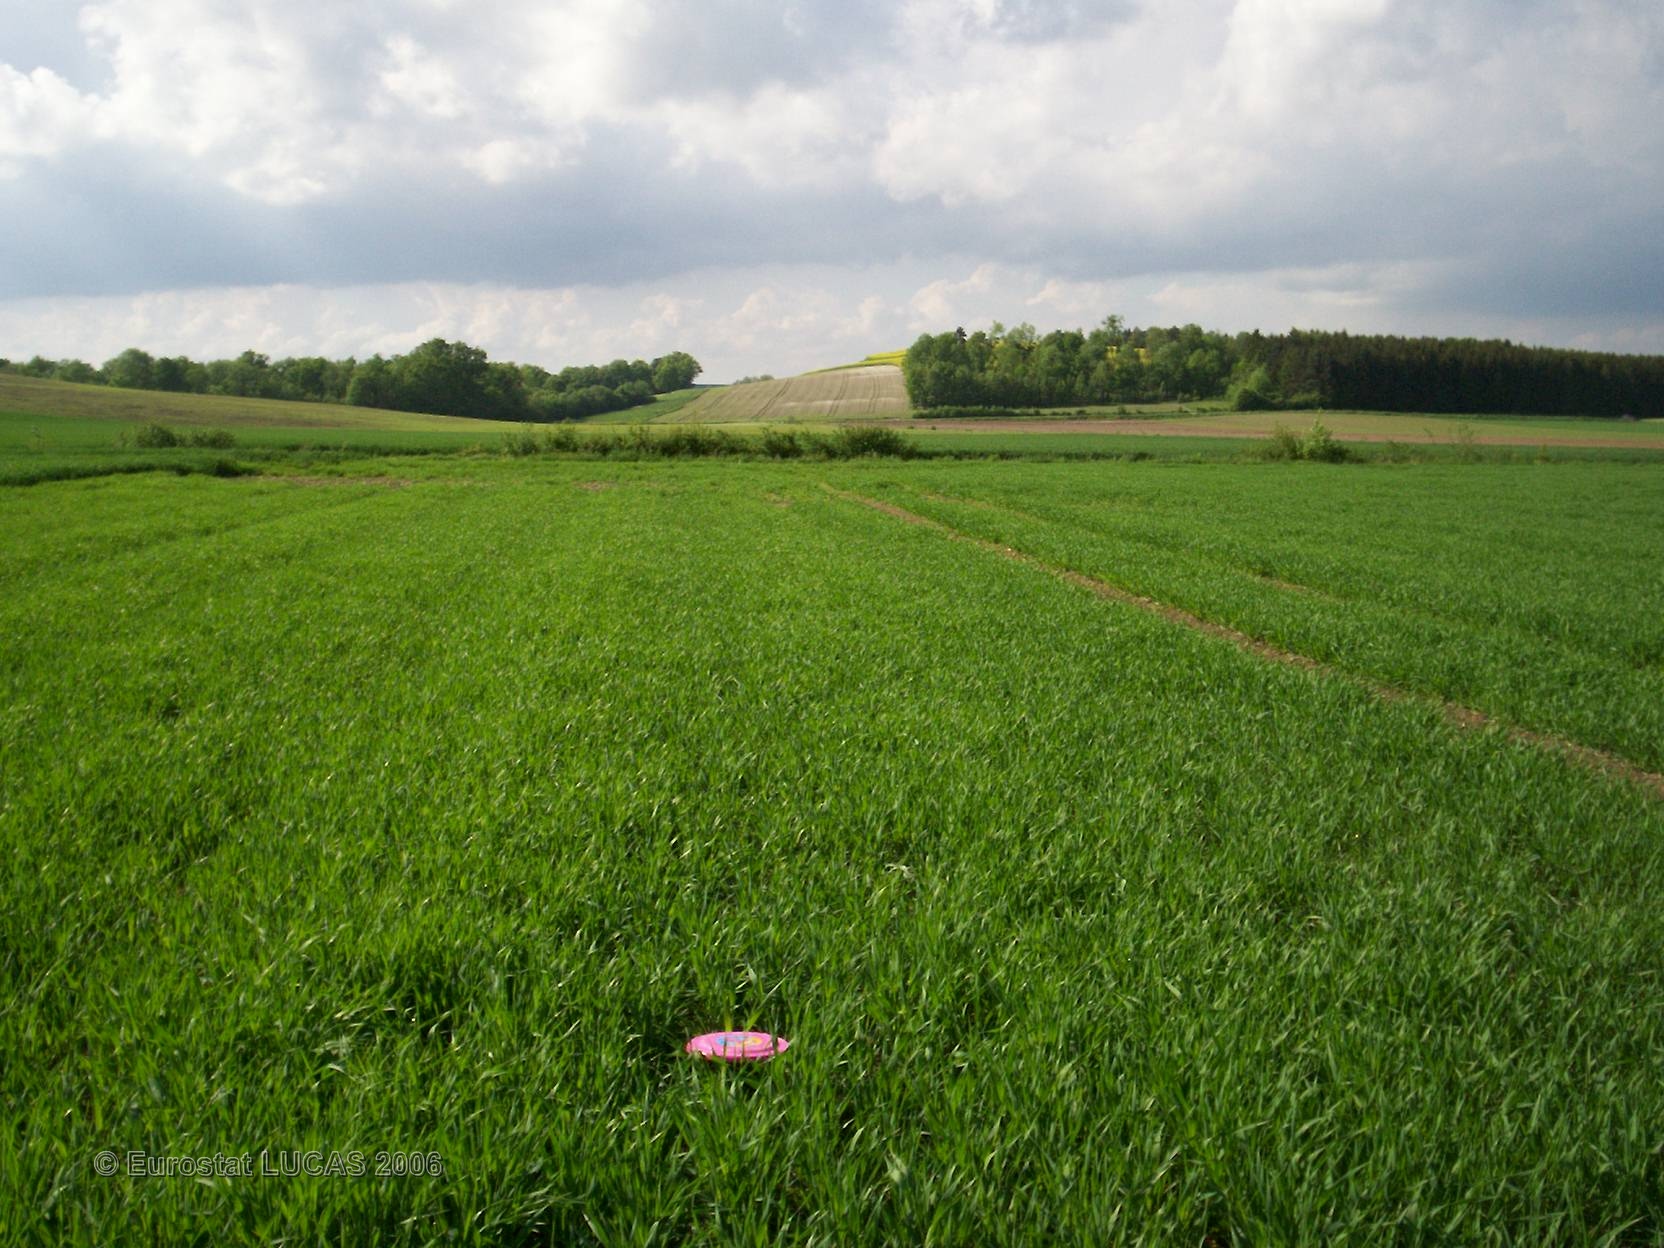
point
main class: Cropland
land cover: Barley
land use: Agriculture (excluding fallow land and kitchen gardens)
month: May
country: FR
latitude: 49.5584
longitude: 4.3693
